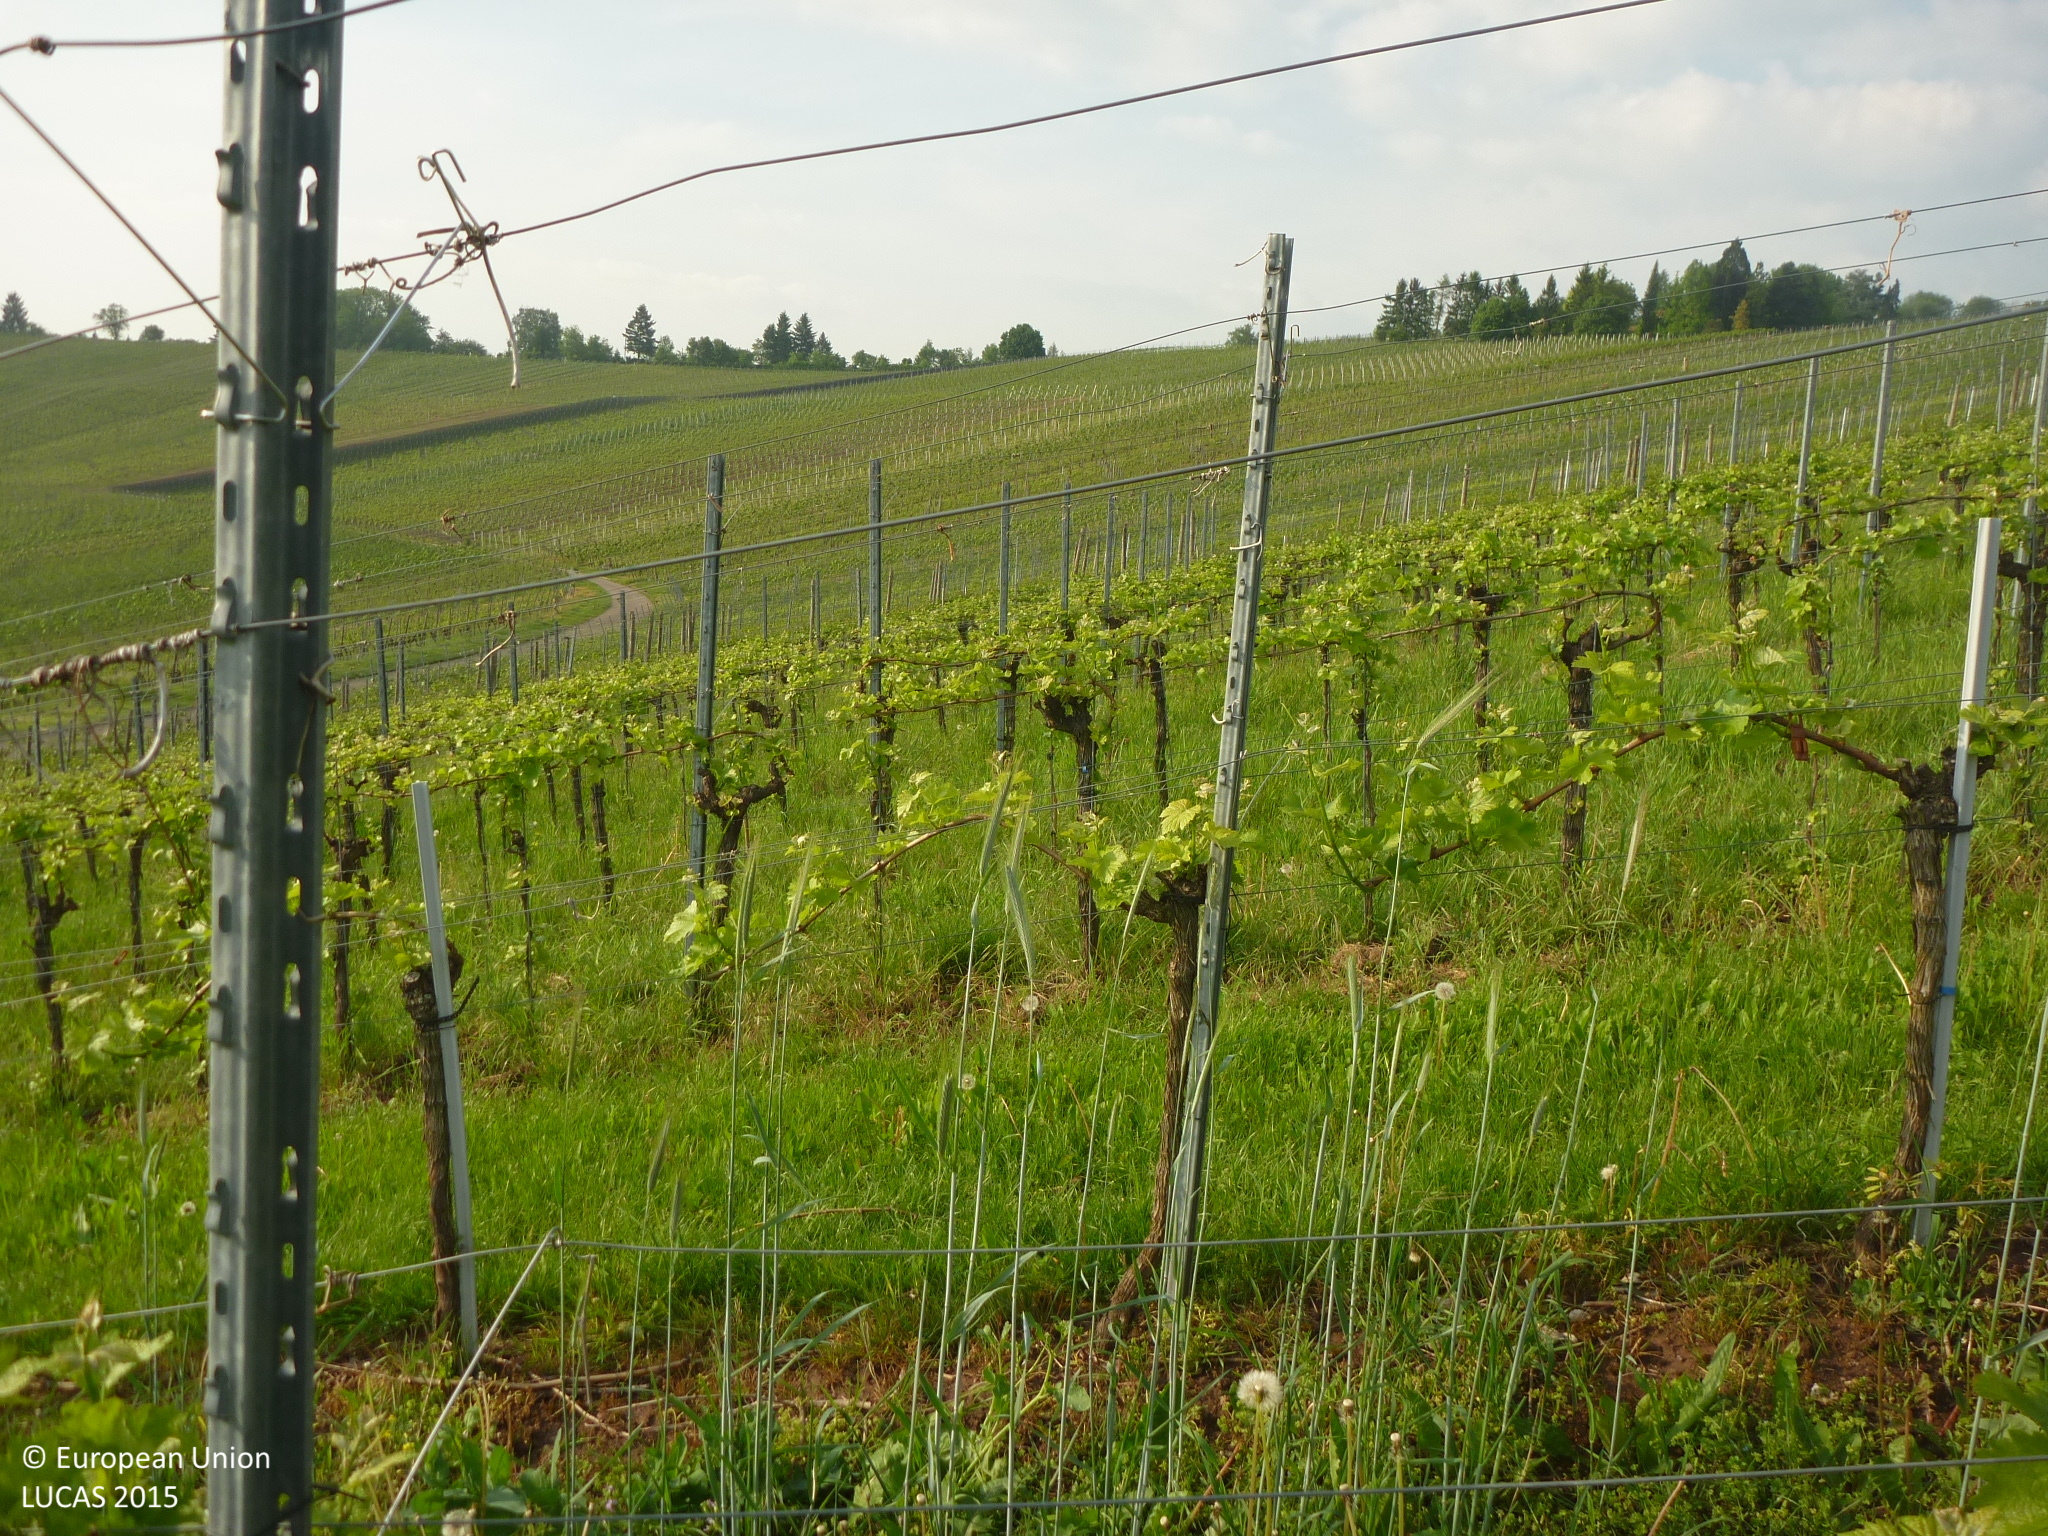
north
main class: Cropland
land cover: Vineyards
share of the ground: 10 - 25 %
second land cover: Grassland without tree/shrub cover
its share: > 75 %
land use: Agriculture (excluding fallow land and kitchen gardens)
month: May
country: DE
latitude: 48.7978
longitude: 9.4149
